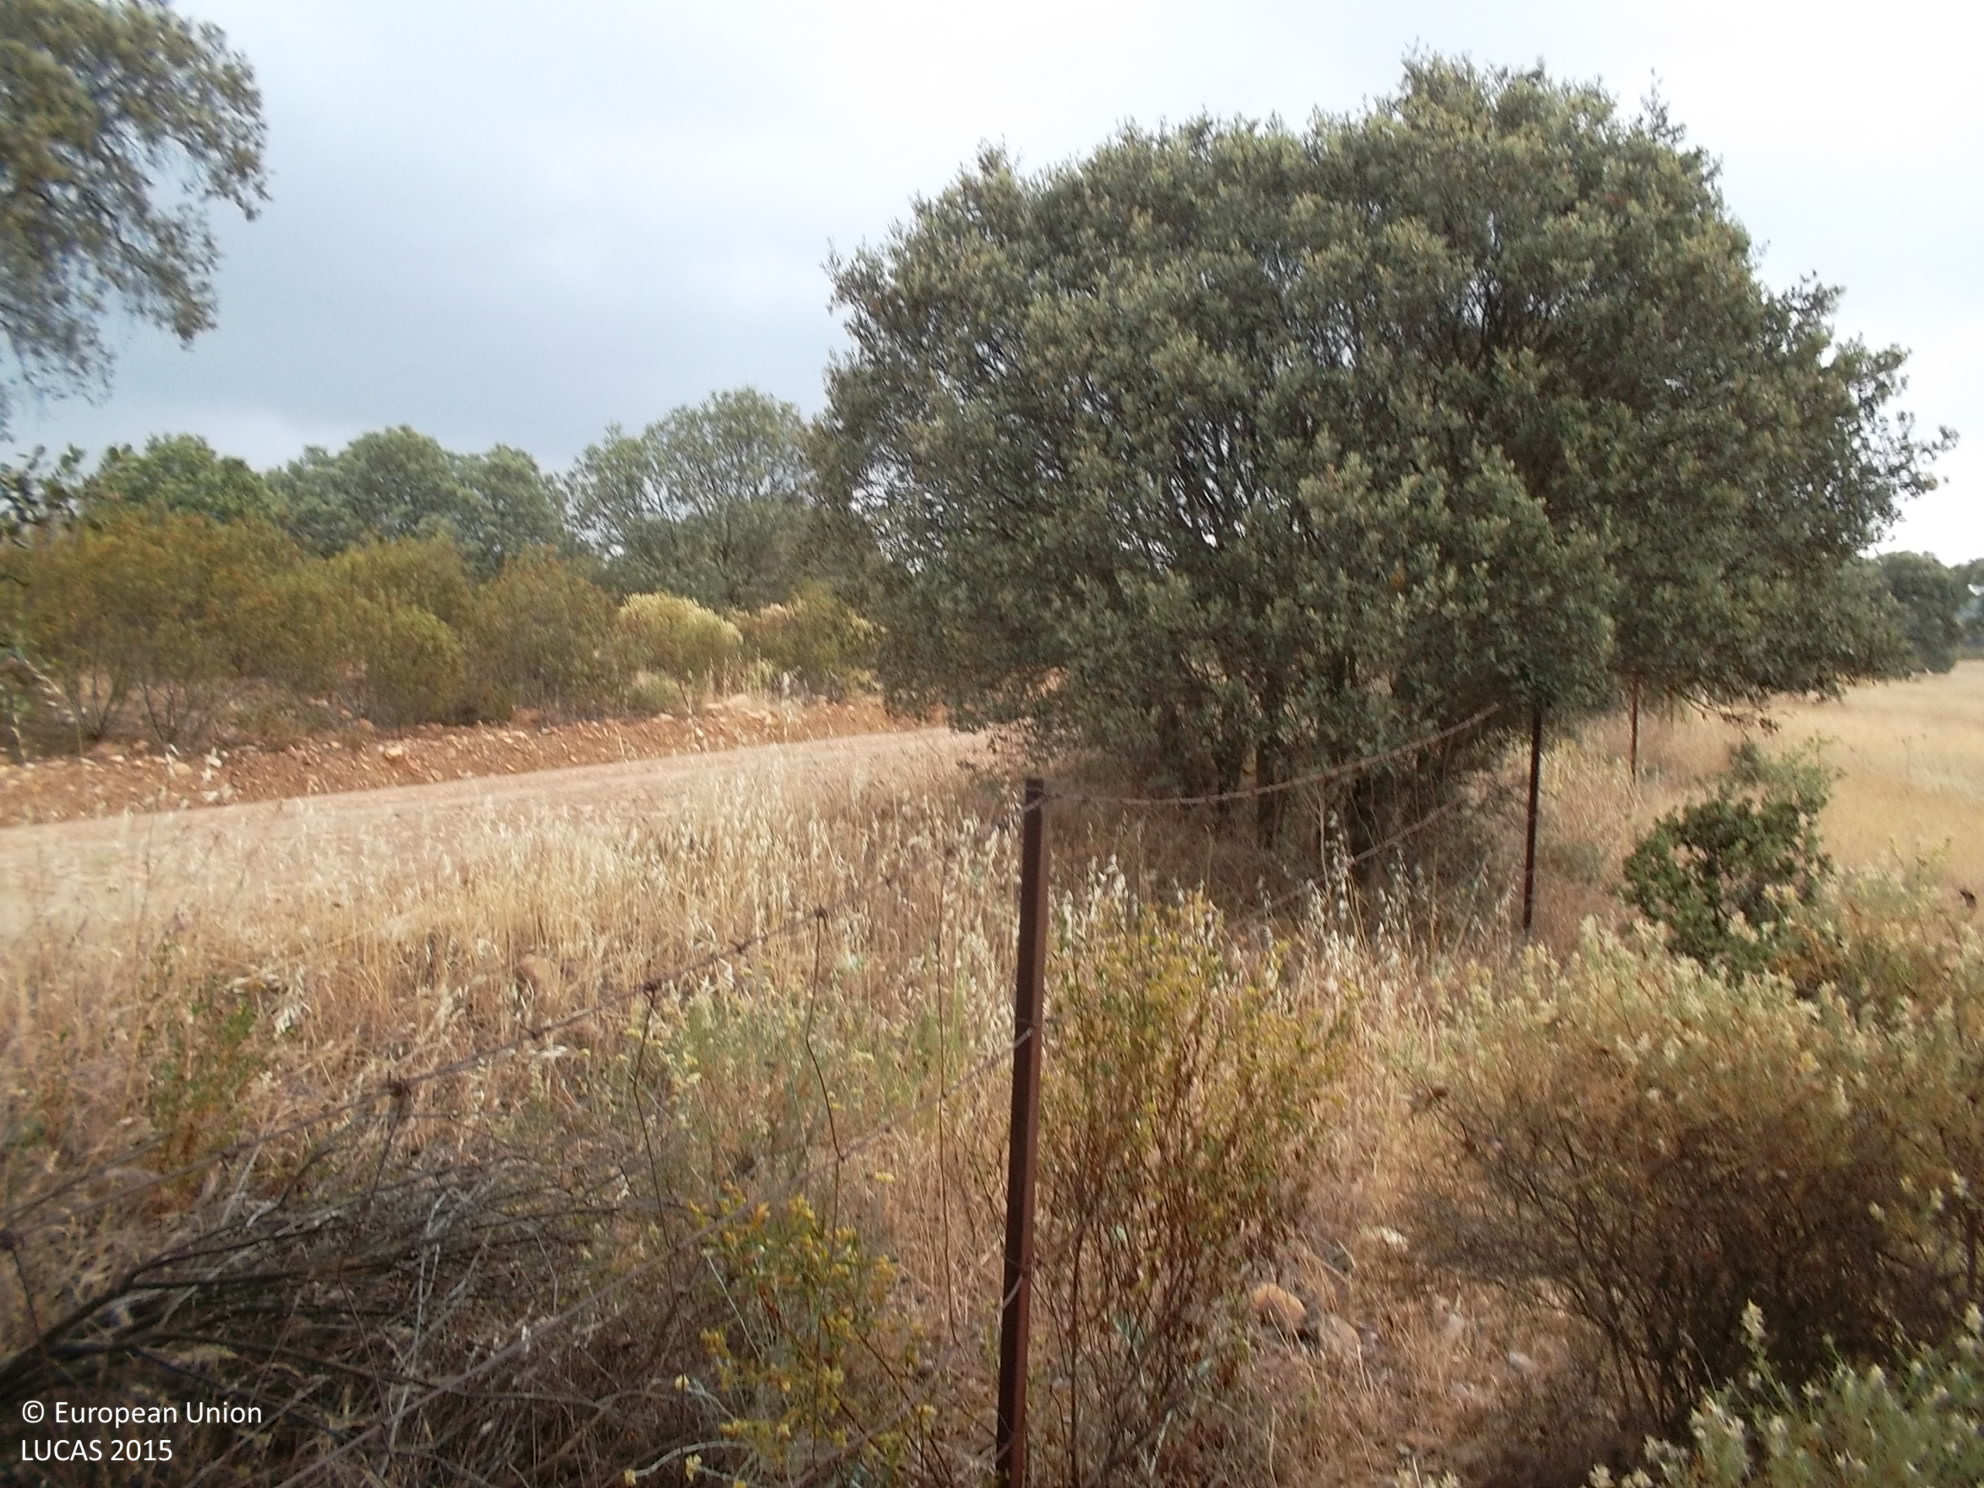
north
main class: Woodland
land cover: Broadleaved woodland
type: broadleaved evergreen forest
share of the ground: 25 - 50 %
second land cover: Grassland without tree/shrub cover
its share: > 75 %
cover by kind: broadleaved forest trees 30 %, herbaceous plants 30 %, shrubs 20 %, unconsolidated bare surface 20 %
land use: Forestry
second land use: Agriculture (excluding fallow land and kitchen gardens)
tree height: > 5 m
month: June
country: ES
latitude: 39.0219
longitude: -4.4777
